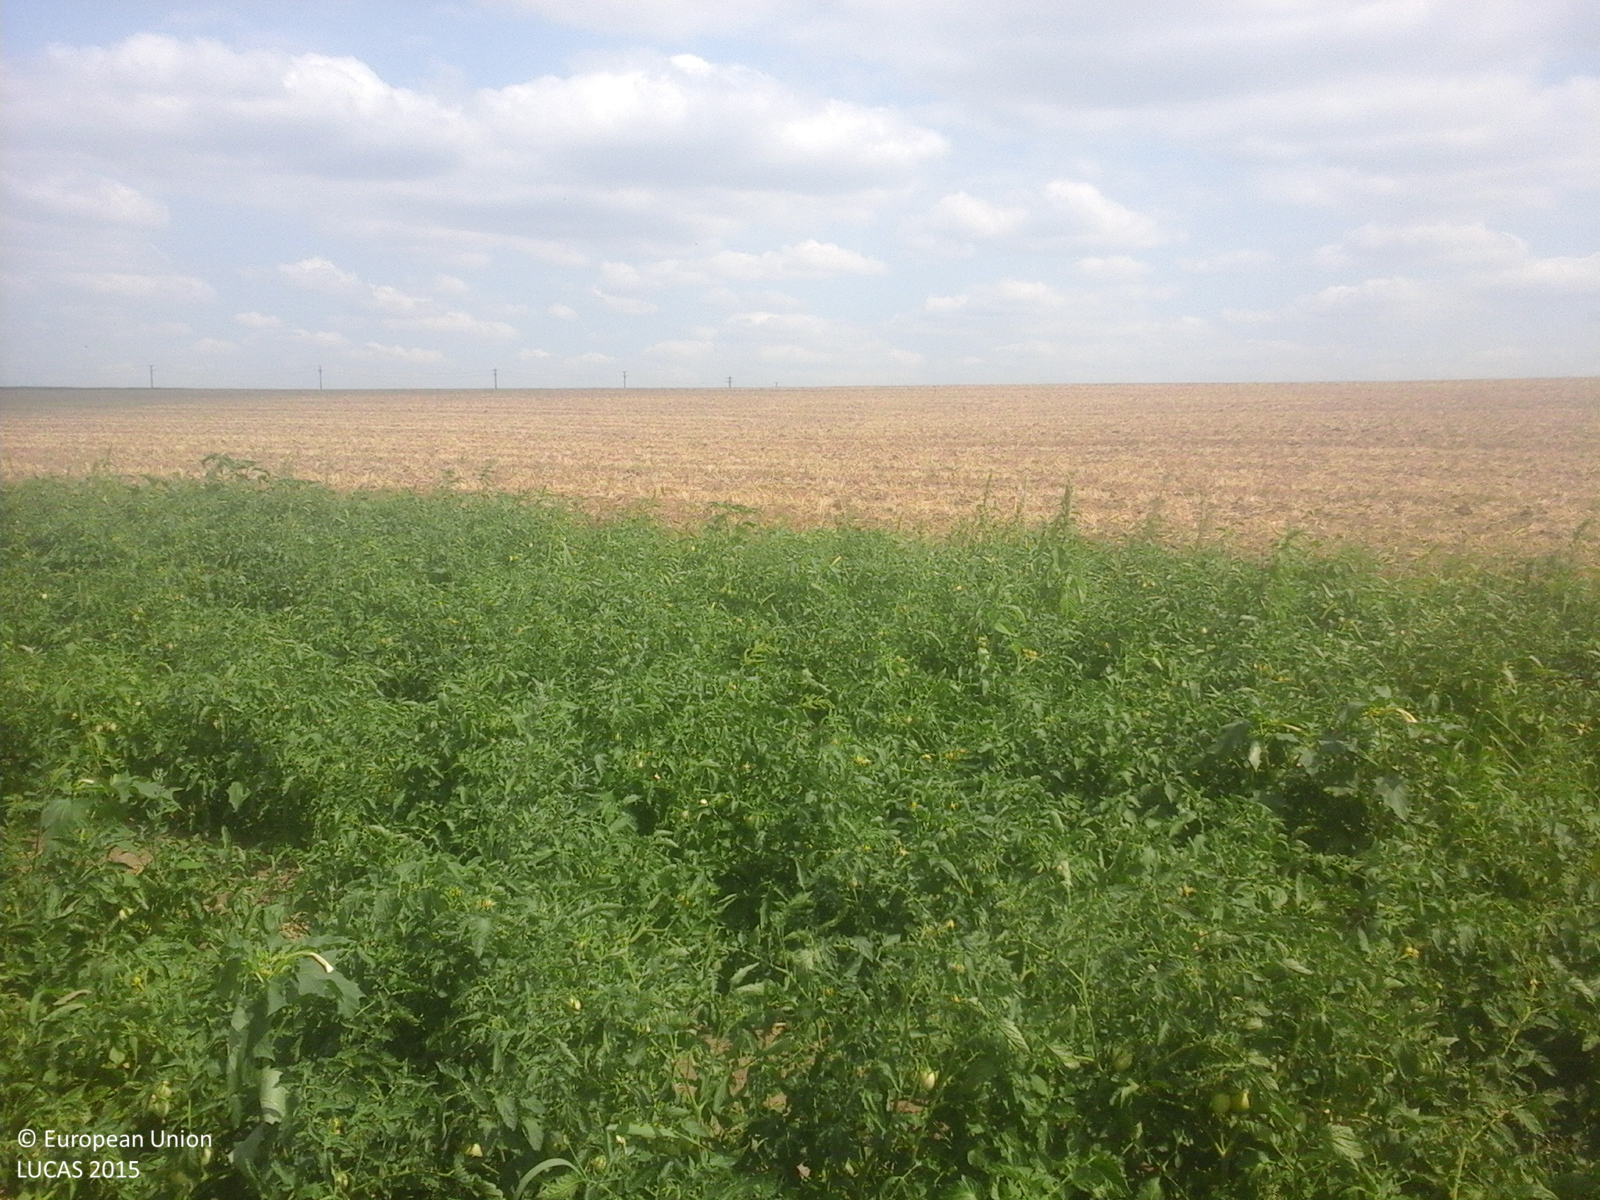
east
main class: Cropland
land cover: Tomatoes
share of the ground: > 75 %
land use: Agriculture (excluding fallow land and kitchen gardens)
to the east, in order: Tomatoes; Common wheat
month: August
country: RO
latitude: 44.6681
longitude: 28.2683
